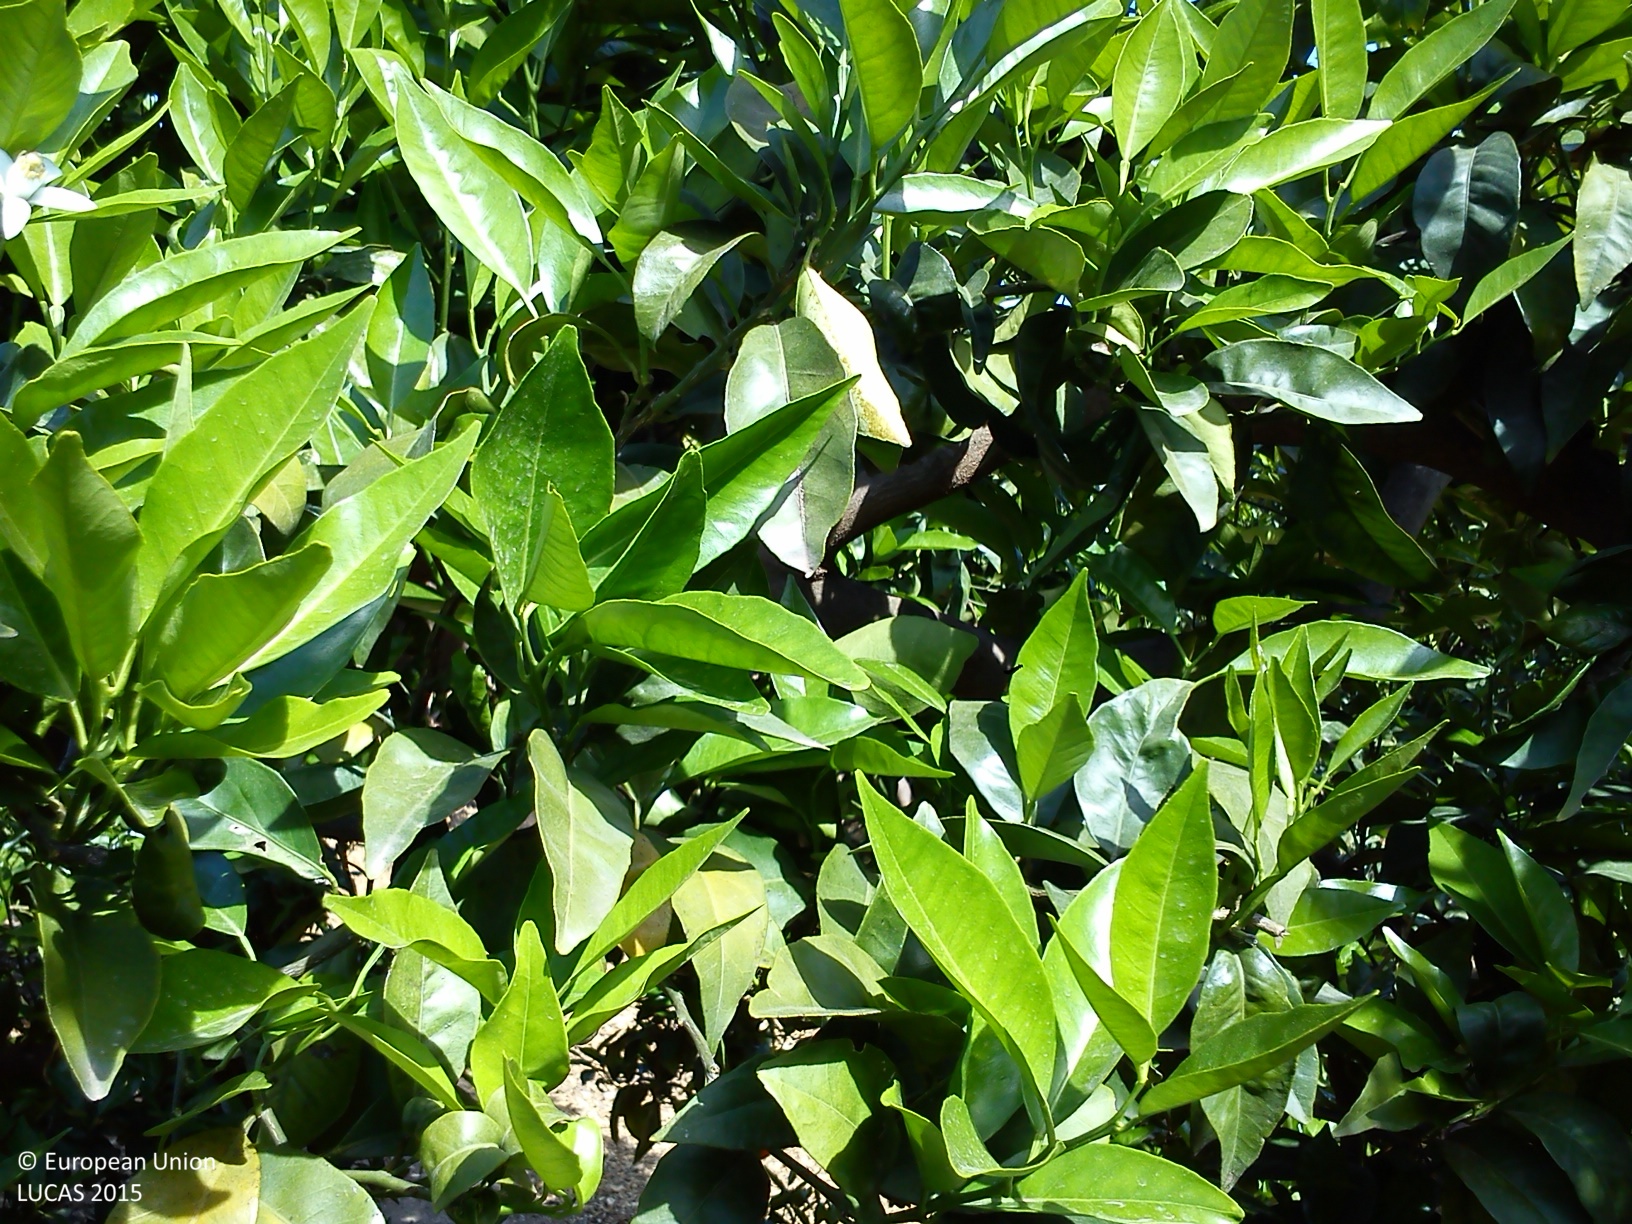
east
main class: Cropland
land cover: Oranges
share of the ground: > 75 %
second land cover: Other bare soil
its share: > 75 %
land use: Agriculture (excluding fallow land and kitchen gardens)
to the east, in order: Oranges; Other bare soil; Fences; Paved roads, cycling and walking lanes; Electric lines; Grassland without tree/shrub cover; Permanent industrial crops; Tracks; Electric lines; Fences; Nuts trees; Fences; Shrubland without tree cover; Ditches and canals; Shrubland without tree cover; Oranges; Shrubland without tree cover; Ditches and canals; Shrubland without tree cover; Fences; Nuts trees; Fences; Nuts trees
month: April
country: ES
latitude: 39.4688
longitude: -0.6342
